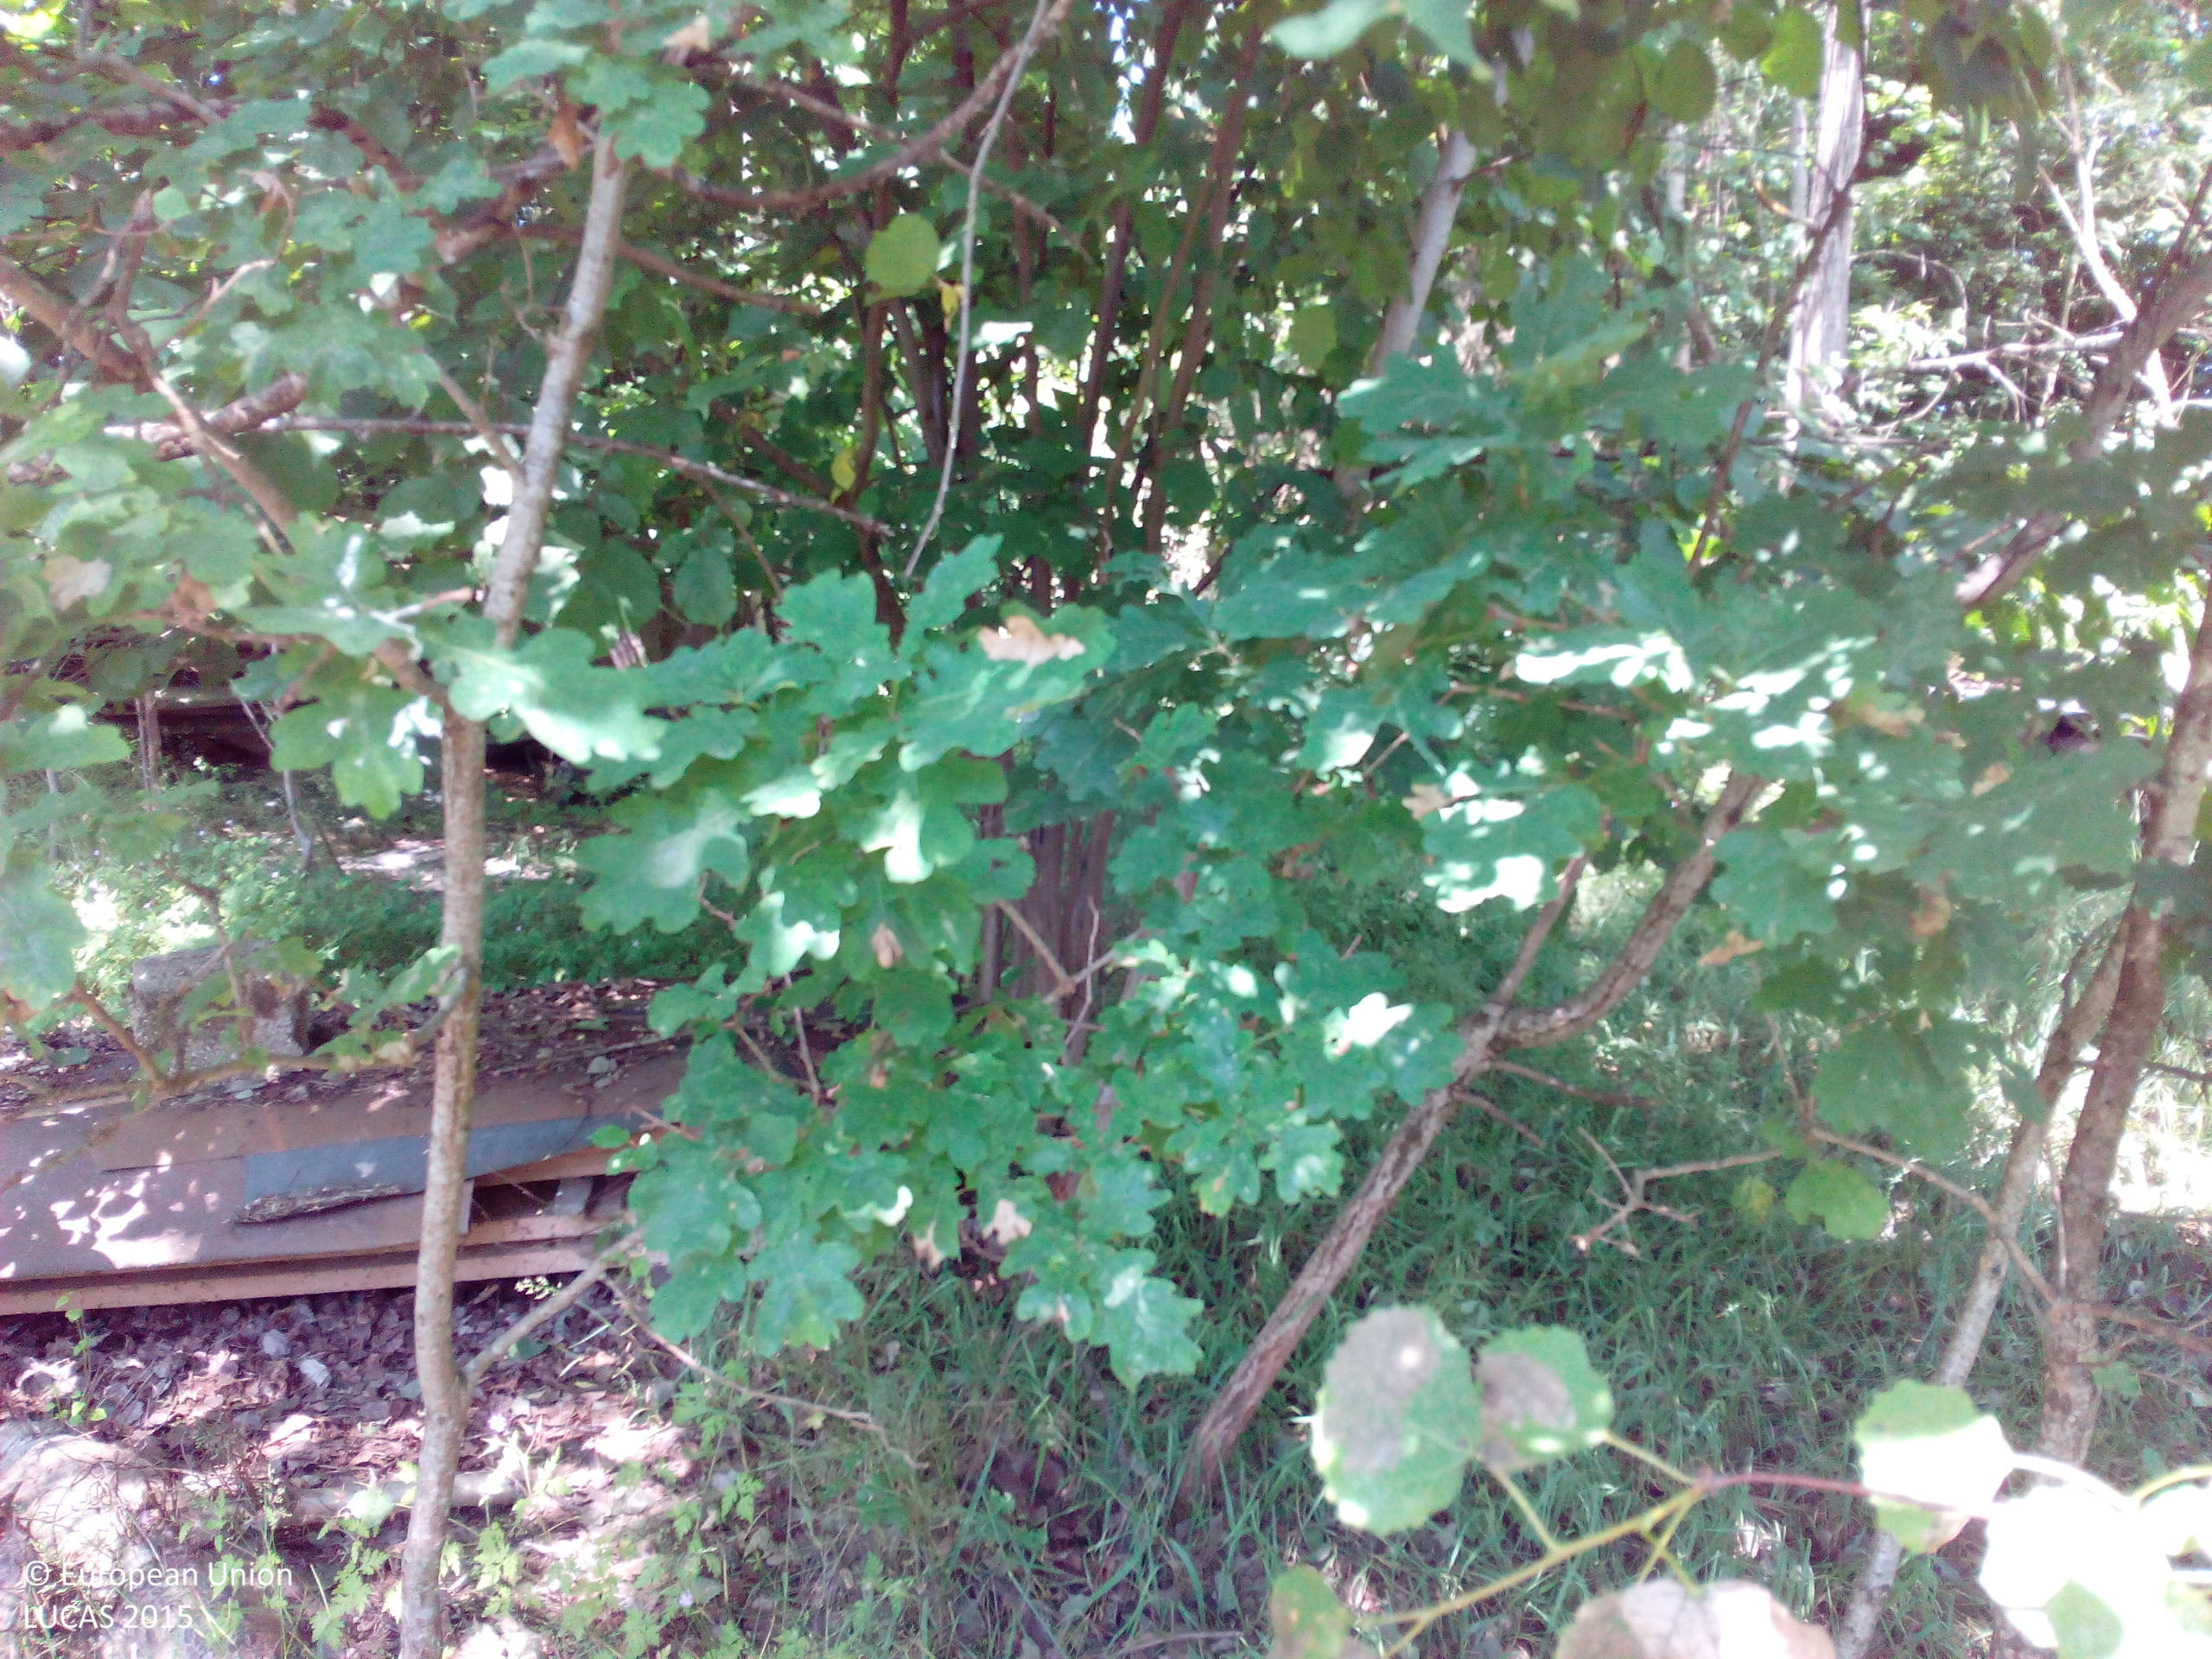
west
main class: Woodland
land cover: Broadleaved woodland
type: mesophytic deciduous forest
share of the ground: > 75 %
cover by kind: broadleaved forest trees 45 %, herbaceous plants 10 %, coniferous forest trees 5 %, lichens and mosses 5 %, unconsolidated bare surface 5 %
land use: Logistics and storage
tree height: > 5 m
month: June
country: DE
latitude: 49.1885
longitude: 12.3457
